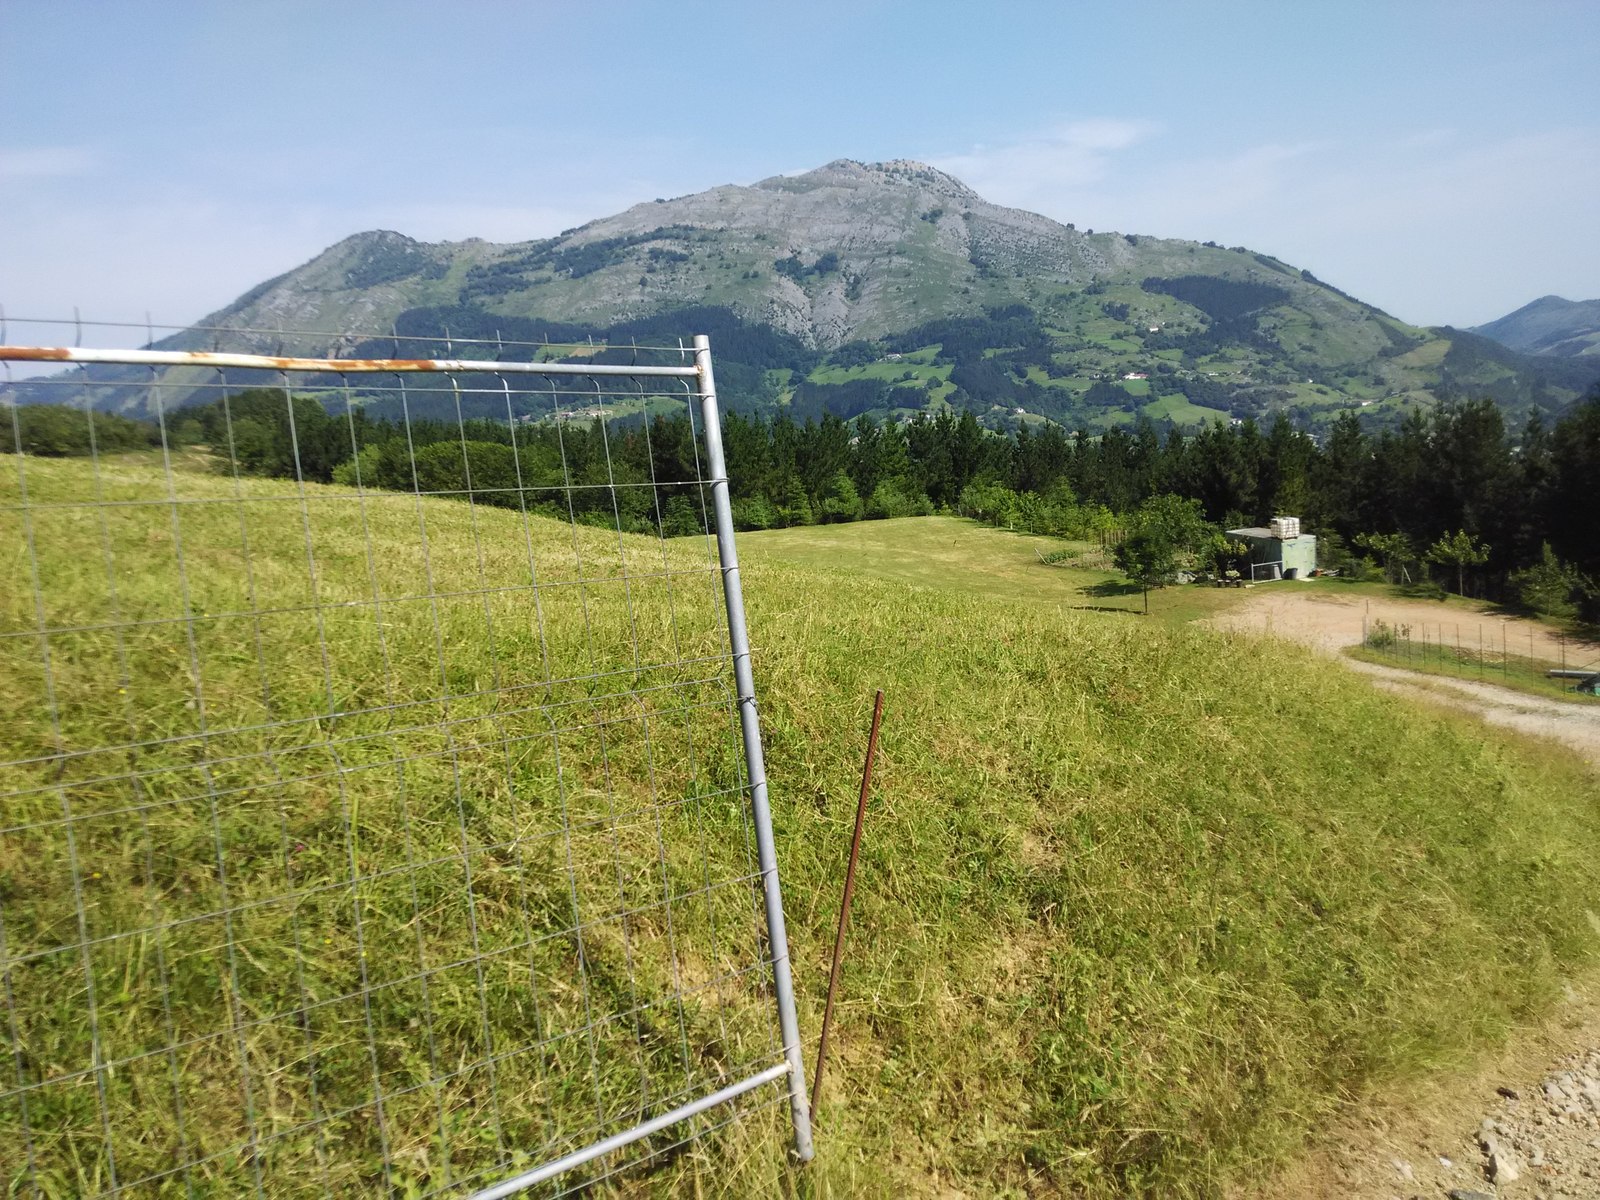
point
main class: Grassland
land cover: Grassland without tree/shrub cover
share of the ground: > 75 %
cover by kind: herbaceous plants 90 %, unconsolidated bare surface 10 %
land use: Agriculture (excluding fallow land and kitchen gardens)
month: July
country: ES
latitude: 43.1645
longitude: -2.2626
